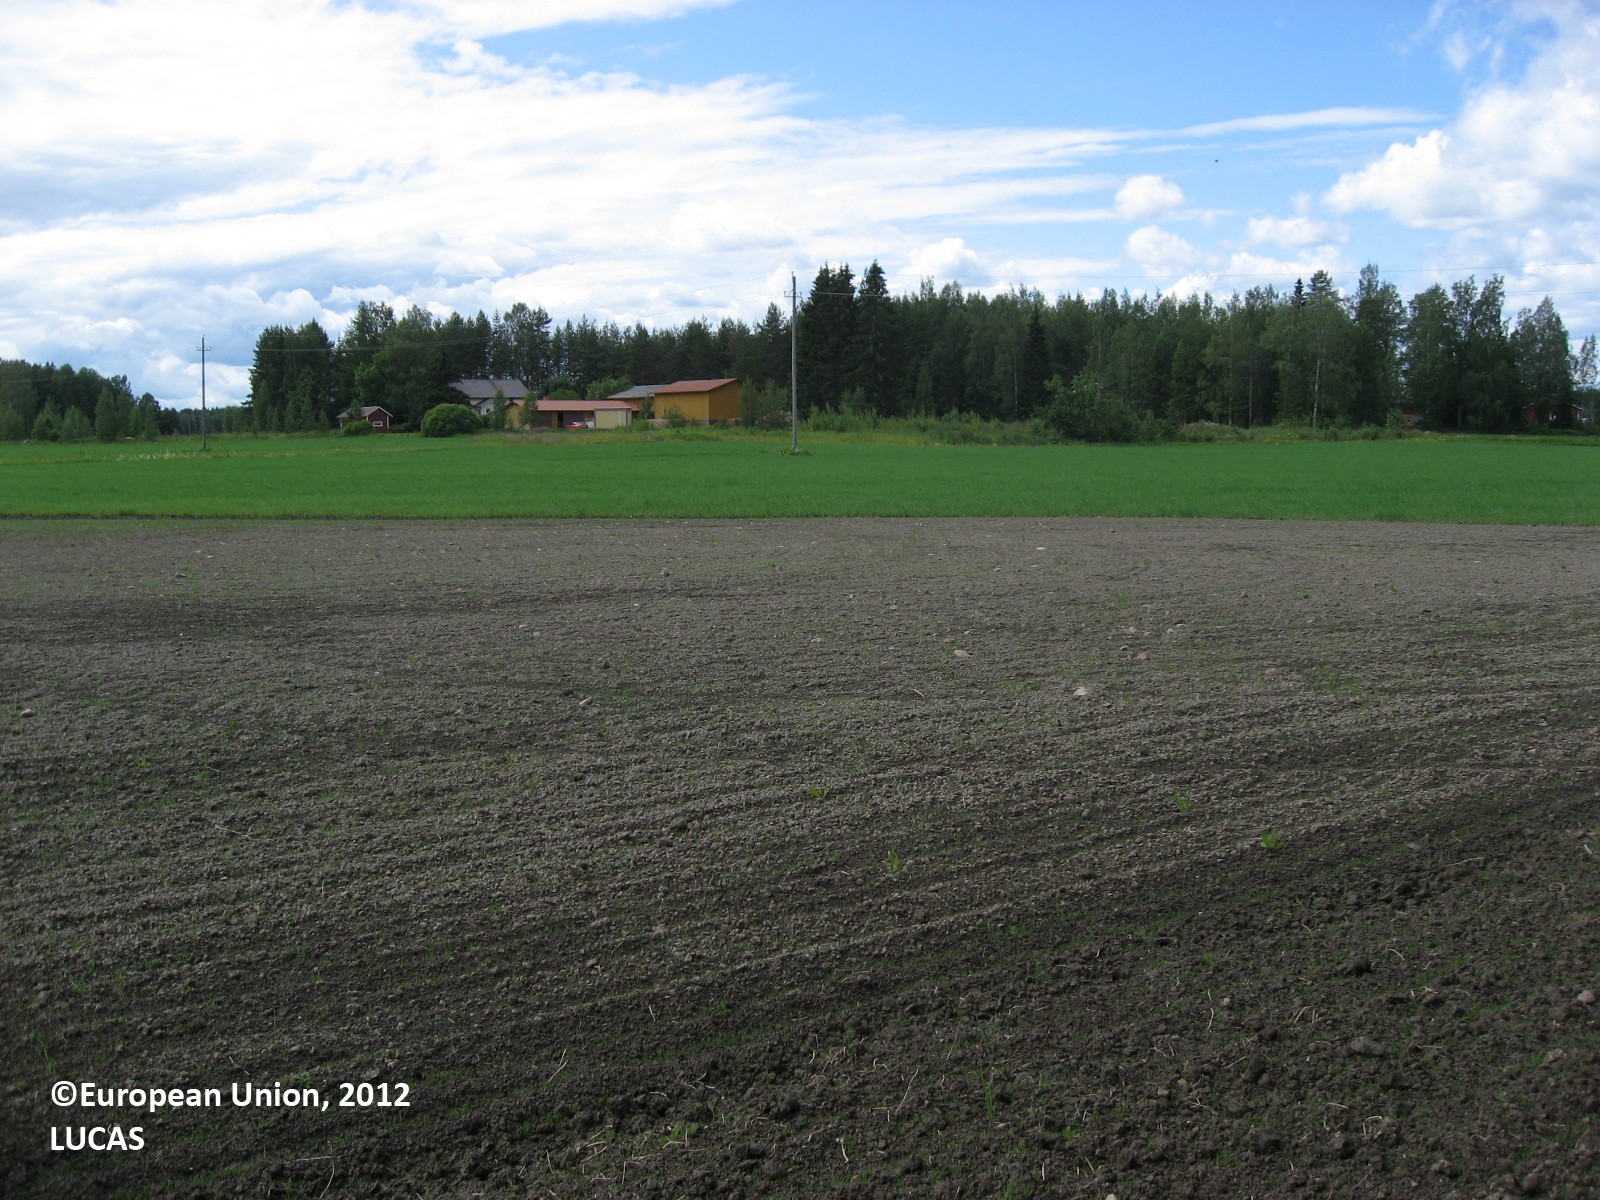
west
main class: Grassland
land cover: Spontaneously vegetated surfaces
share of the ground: < 10 %
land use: Fallow land
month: June
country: FI
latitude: 60.7964
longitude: 26.4116
